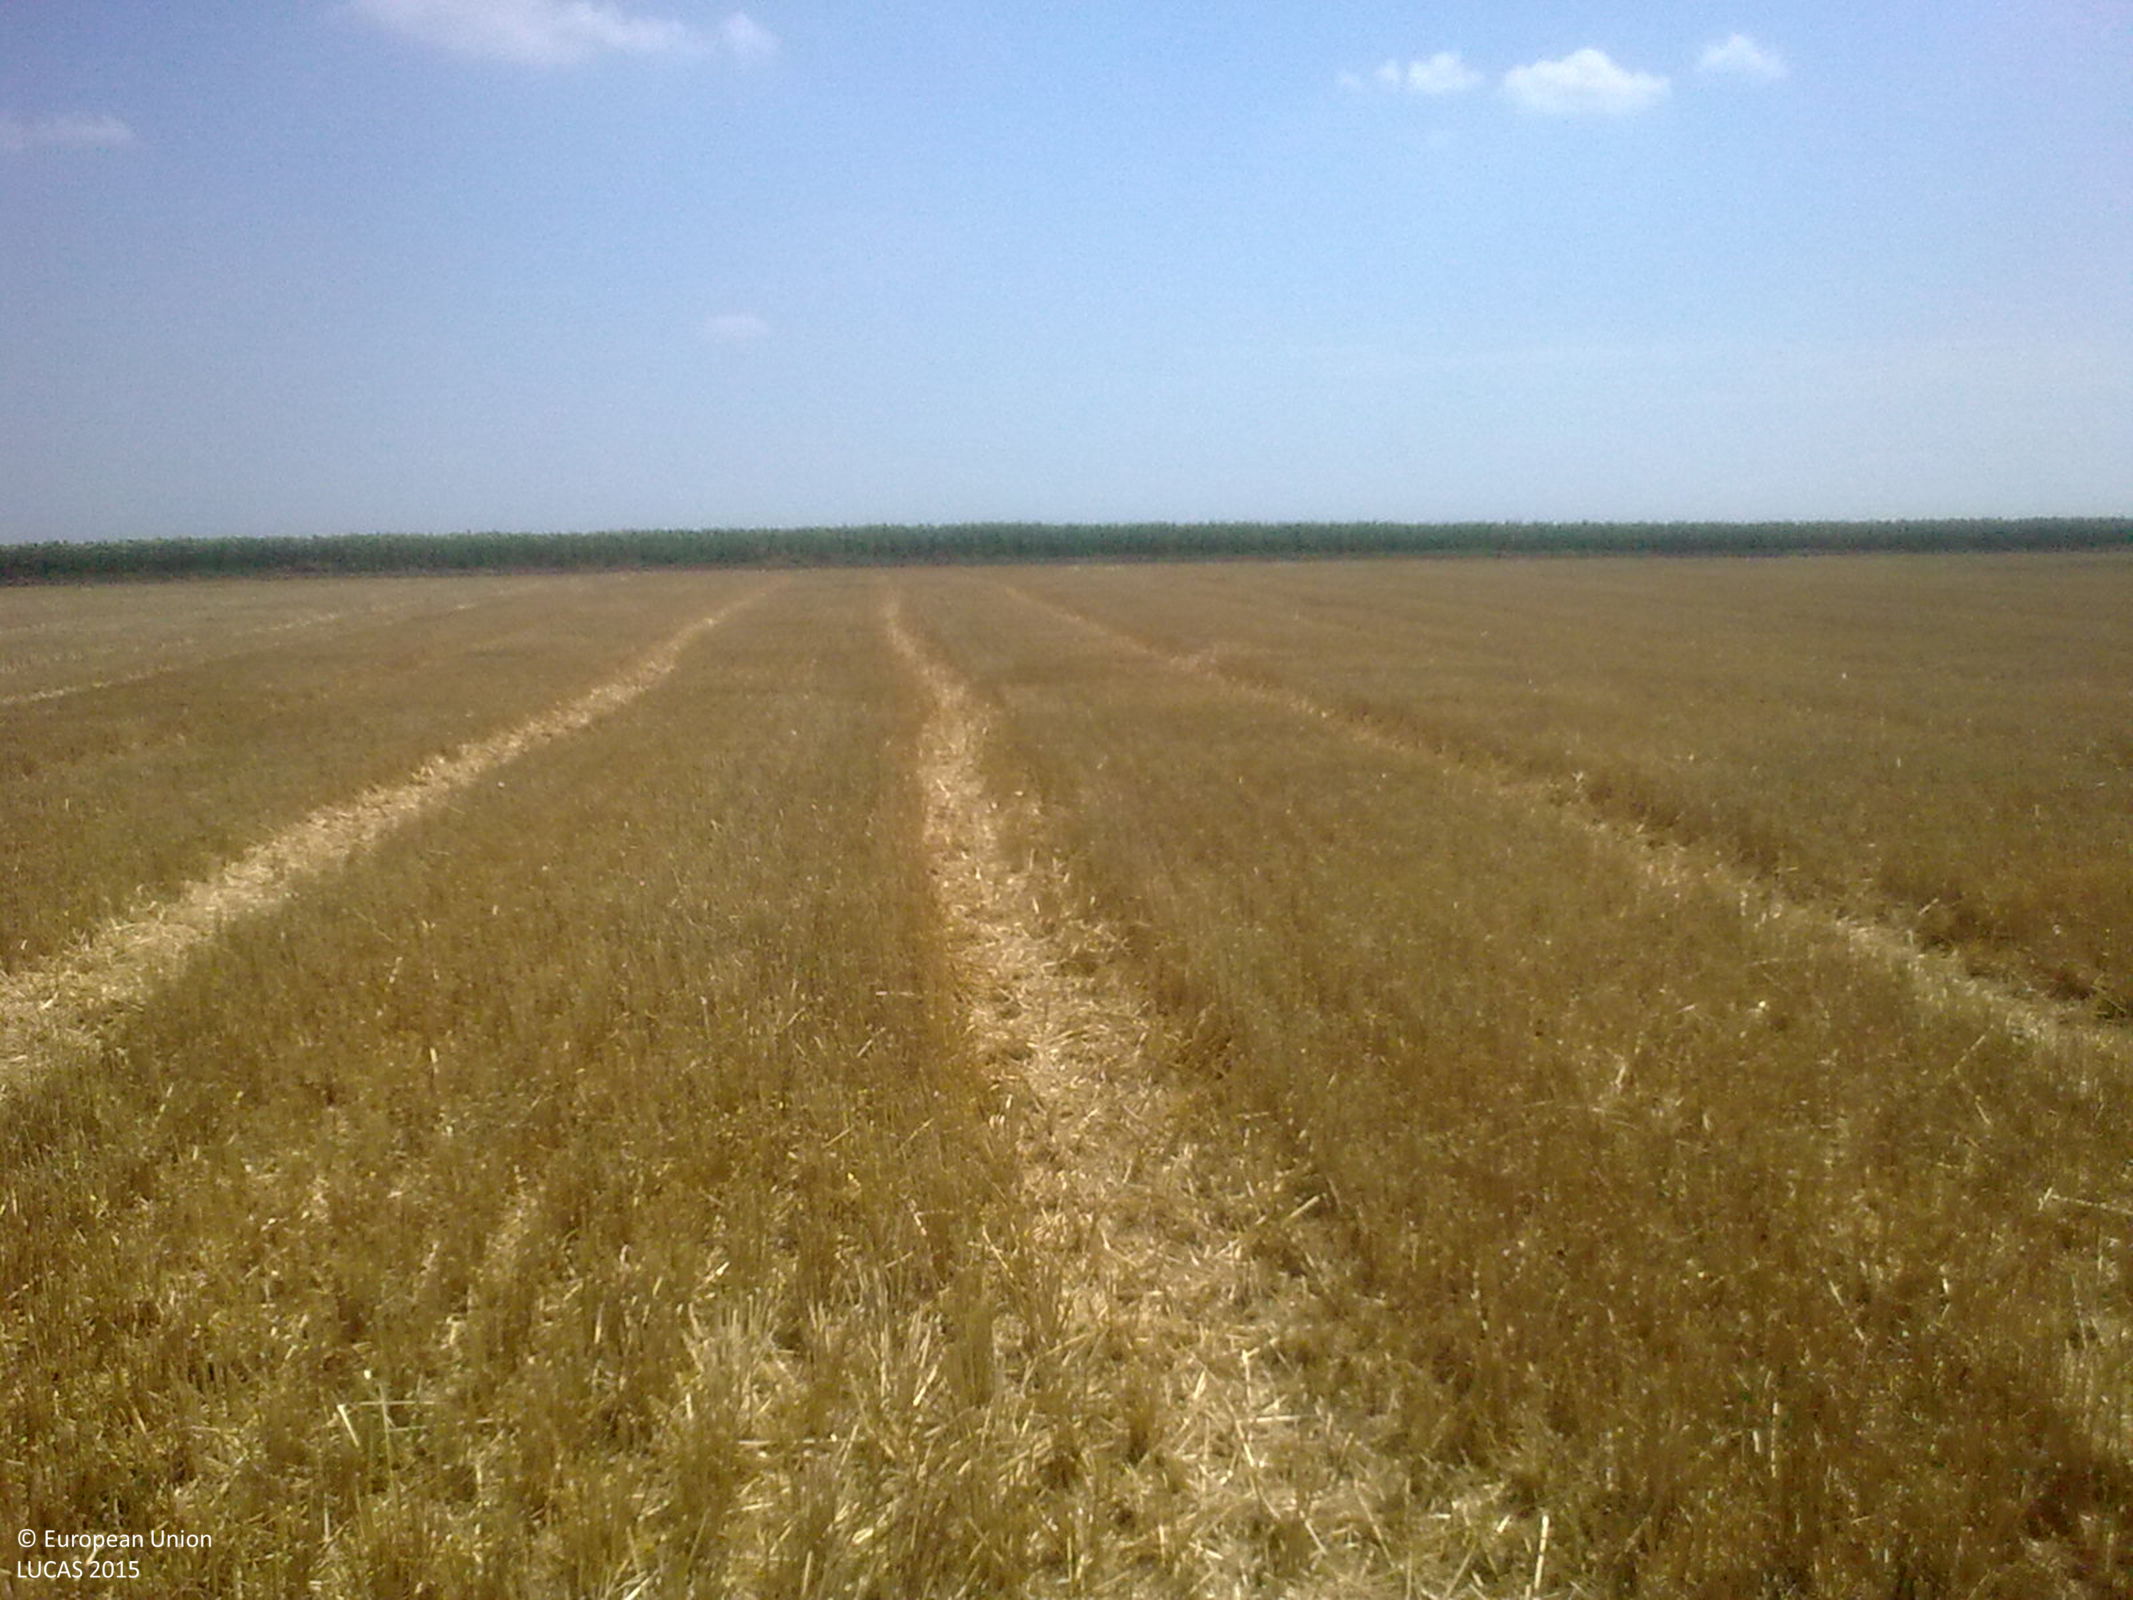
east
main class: Cropland
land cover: Common wheat
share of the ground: > 75 %
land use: Agriculture (excluding fallow land and kitchen gardens)
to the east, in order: Common wheat; Grass margins; Tracks; Grass margins; Sunflower
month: July
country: BG
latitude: 43.7948
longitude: 26.2459
